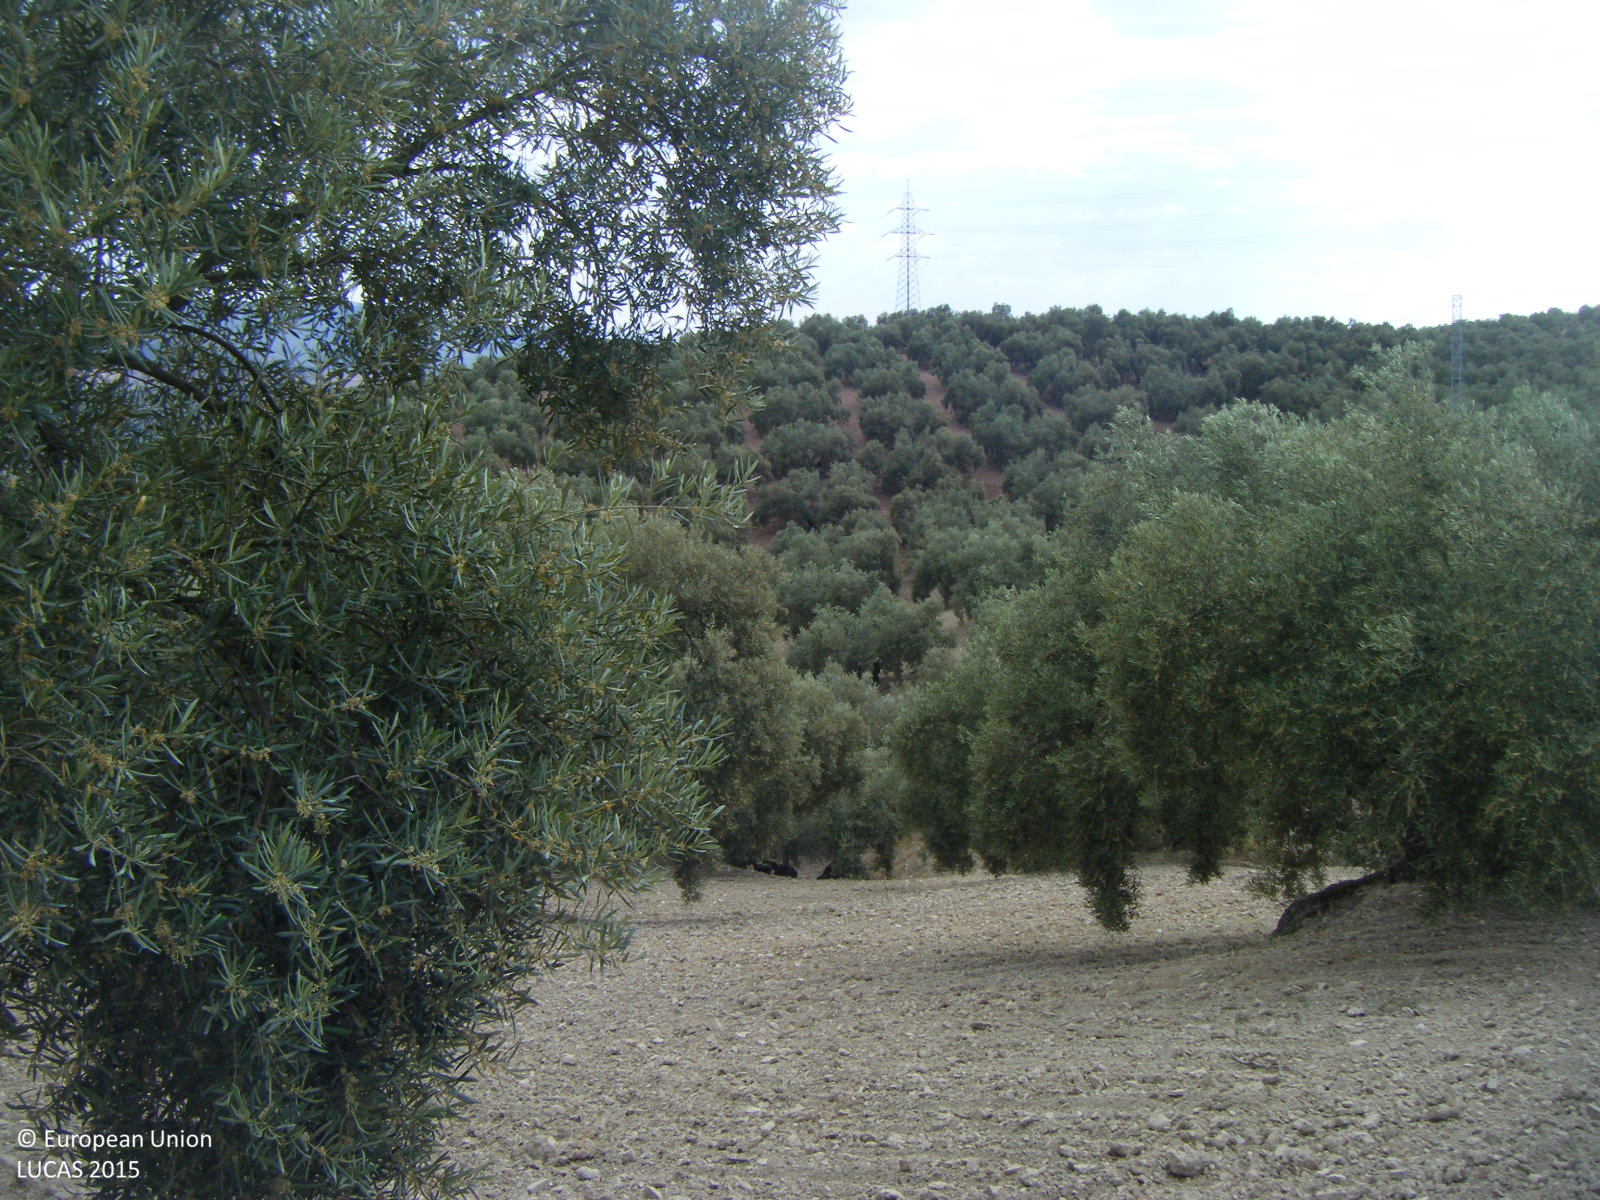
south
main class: Cropland
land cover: Olive groves
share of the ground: 10 - 25 %
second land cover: Other bare soil
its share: > 75 %
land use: Agriculture (excluding fallow land and kitchen gardens)
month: May
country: ES
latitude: 37.2137
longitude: -4.4109
